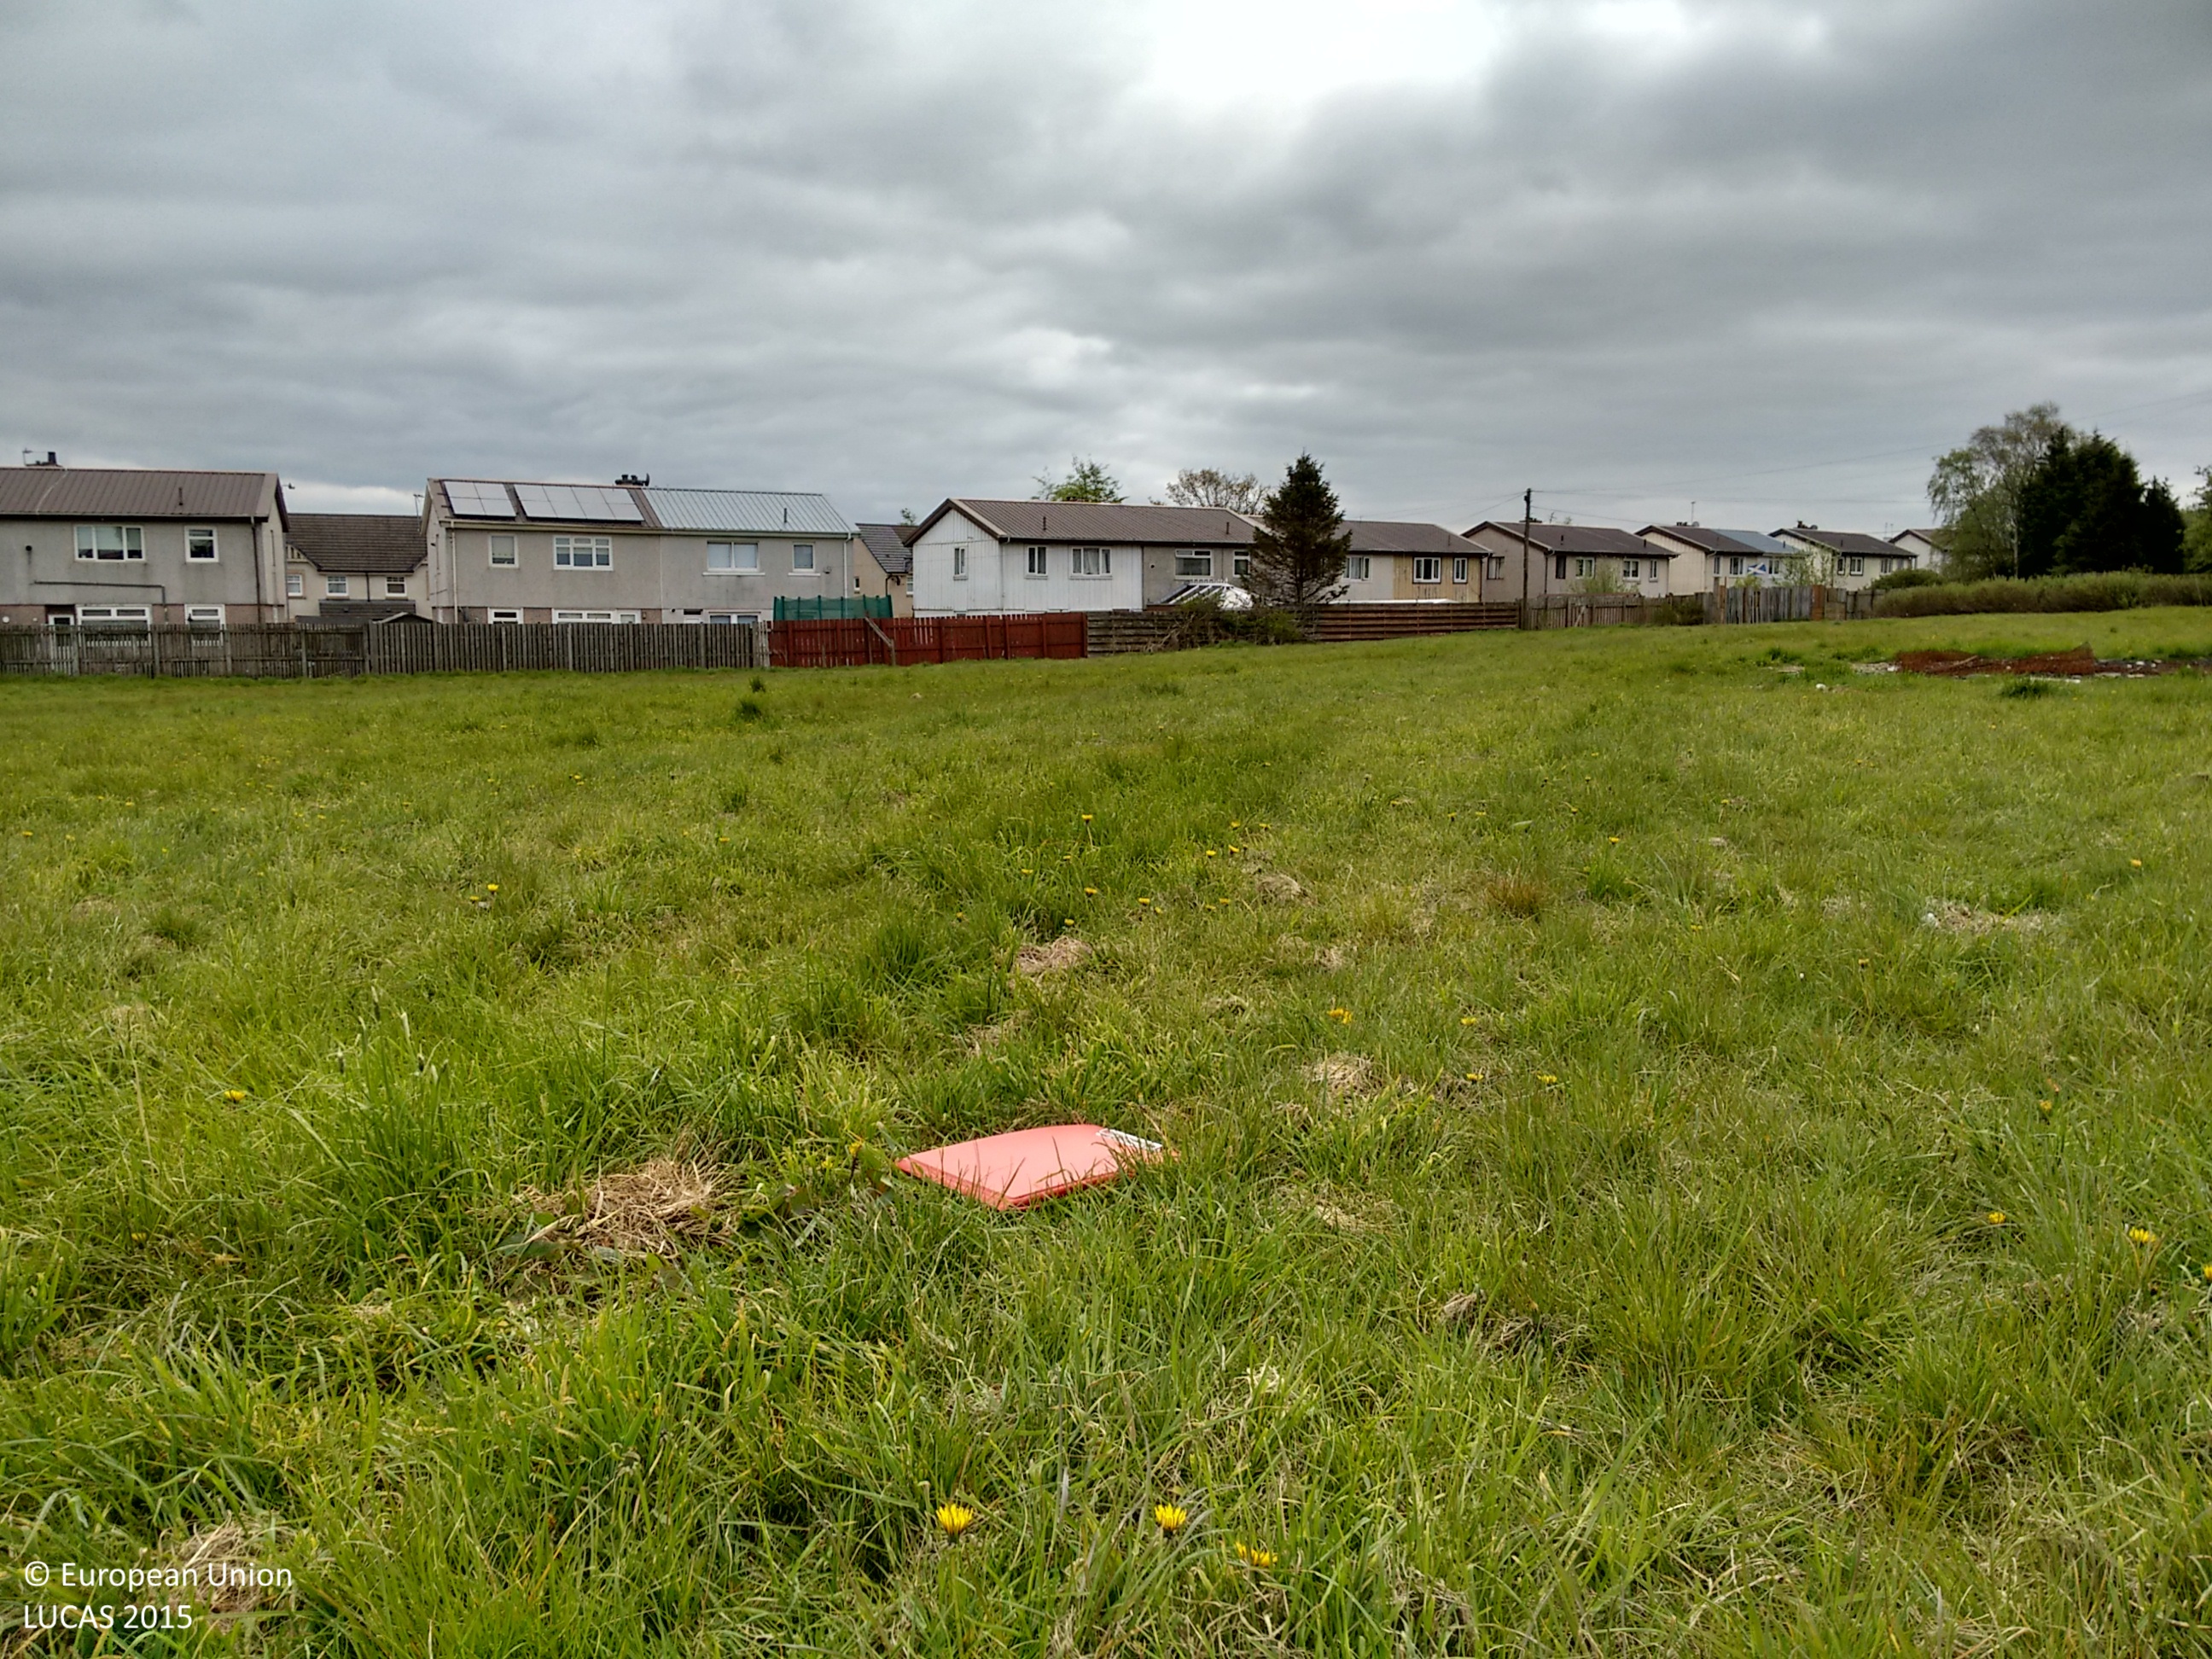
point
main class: Grassland
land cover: Grassland without tree/shrub cover
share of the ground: > 75 %
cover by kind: herbaceous plants 100 %
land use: Amenities, museums, leisure
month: May
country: GB
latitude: 55.8852
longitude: -4.2090
